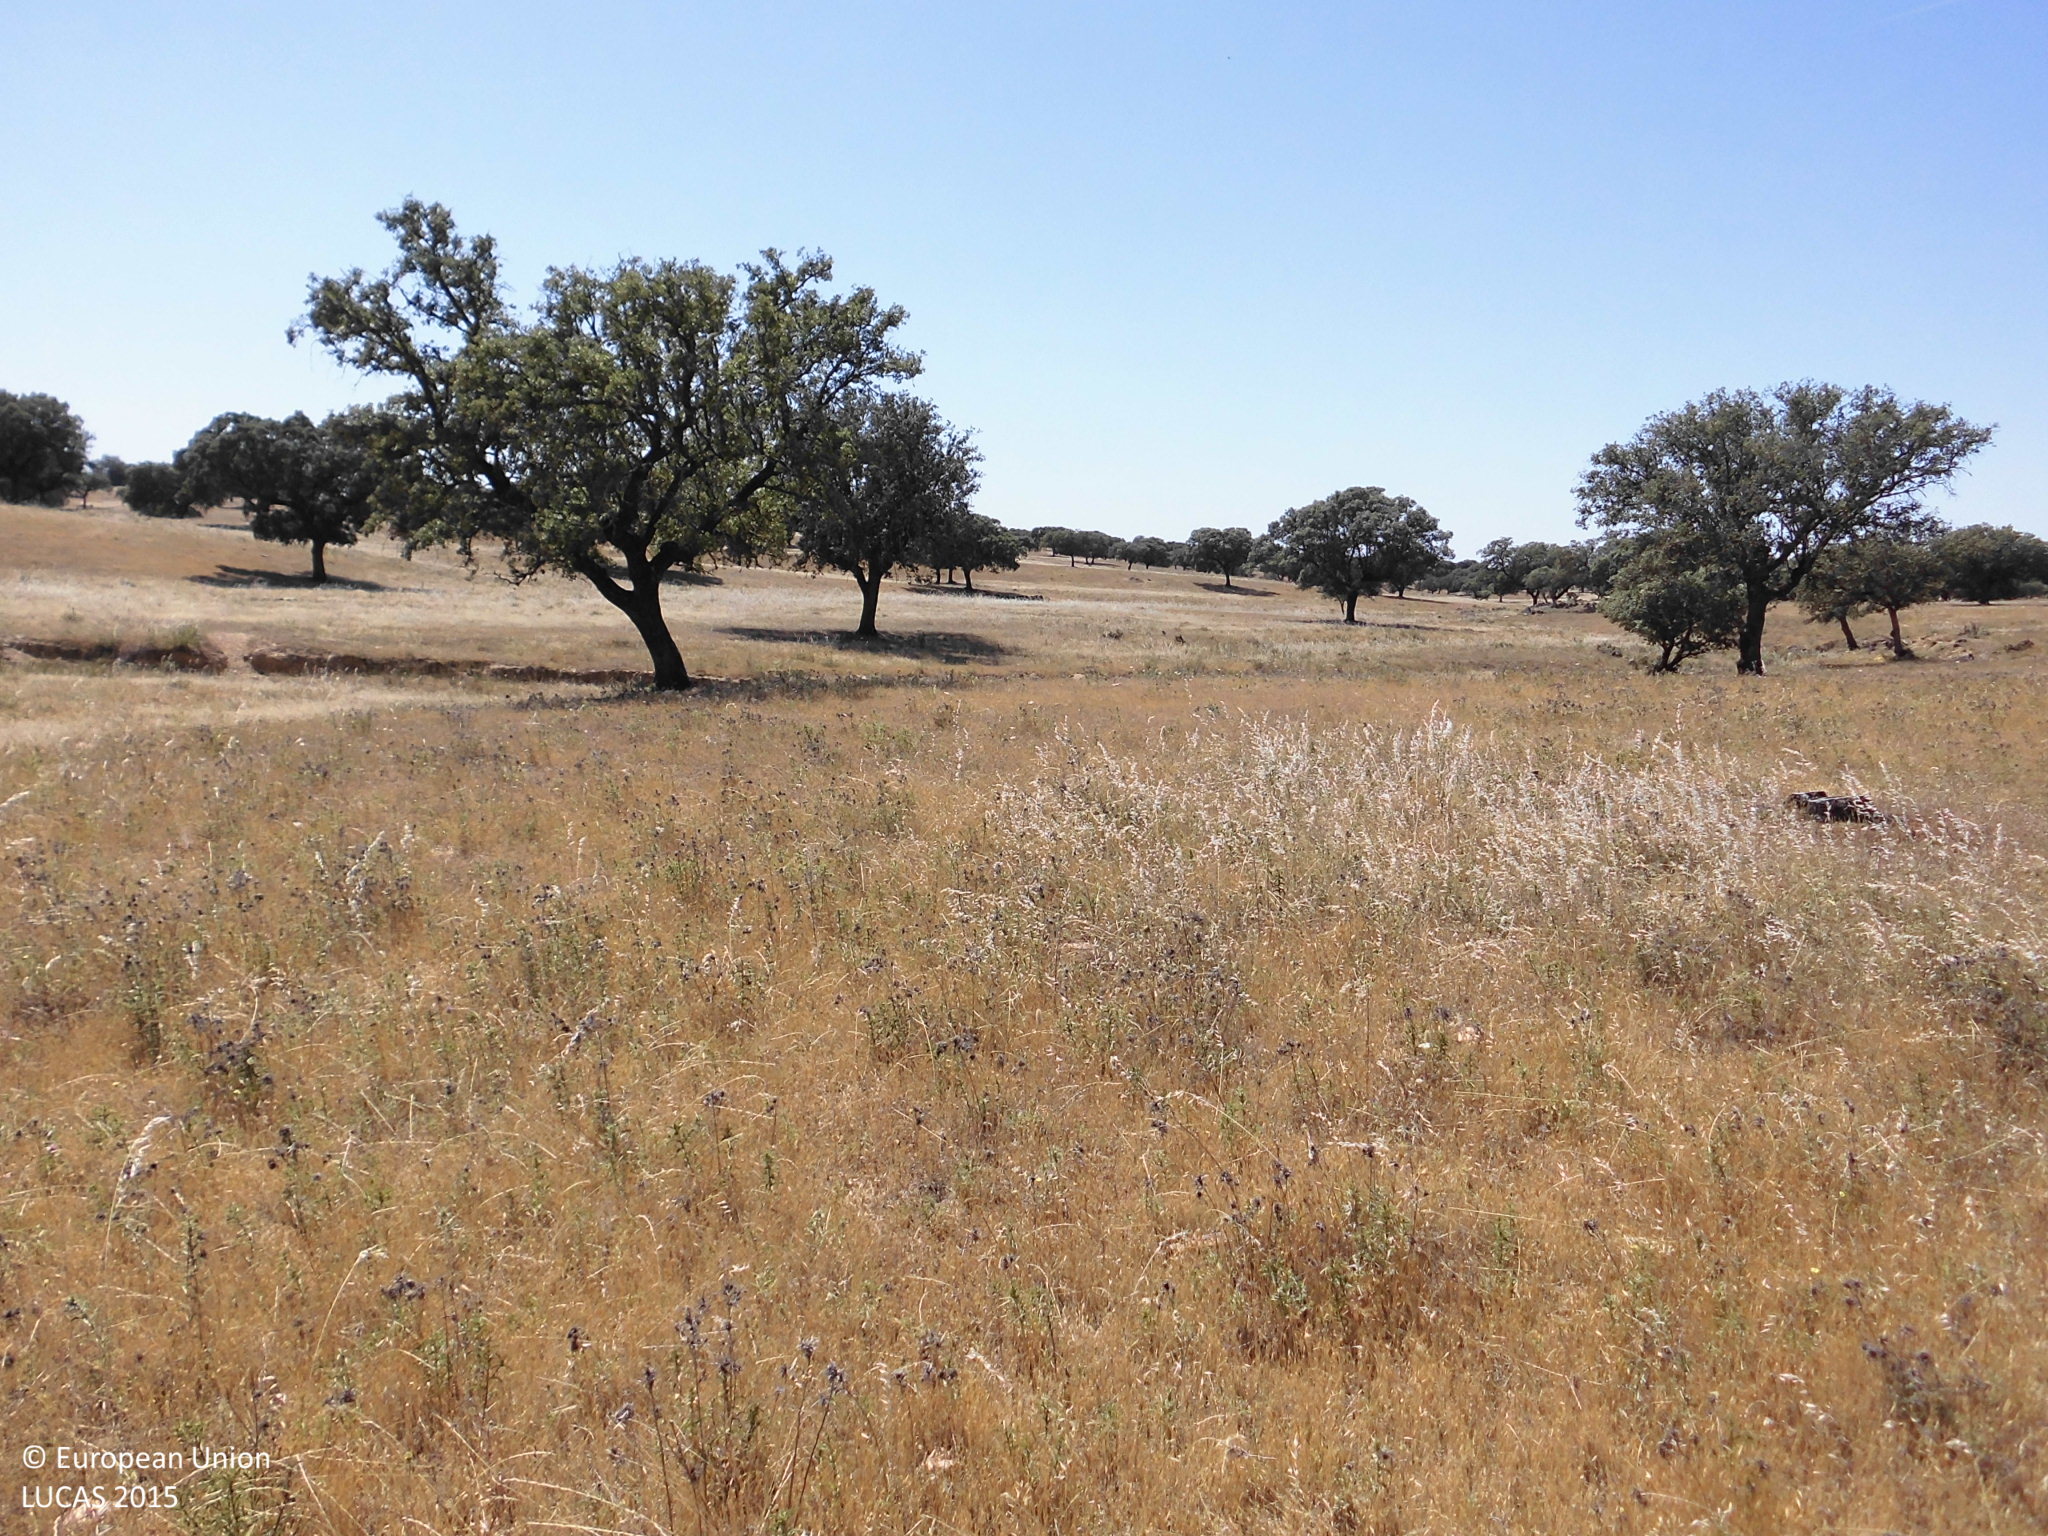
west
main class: Woodland
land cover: Broadleaved woodland
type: broadleaved evergreen forest
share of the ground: 10 - 25 %
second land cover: Grassland without tree/shrub cover
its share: > 75 %
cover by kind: herbaceous plants 90 %, broadleaved forest trees 10 %
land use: Forestry
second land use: Agriculture (excluding fallow land and kitchen gardens)
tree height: > 5 m
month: May
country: ES
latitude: 39.4131
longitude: -6.8126
